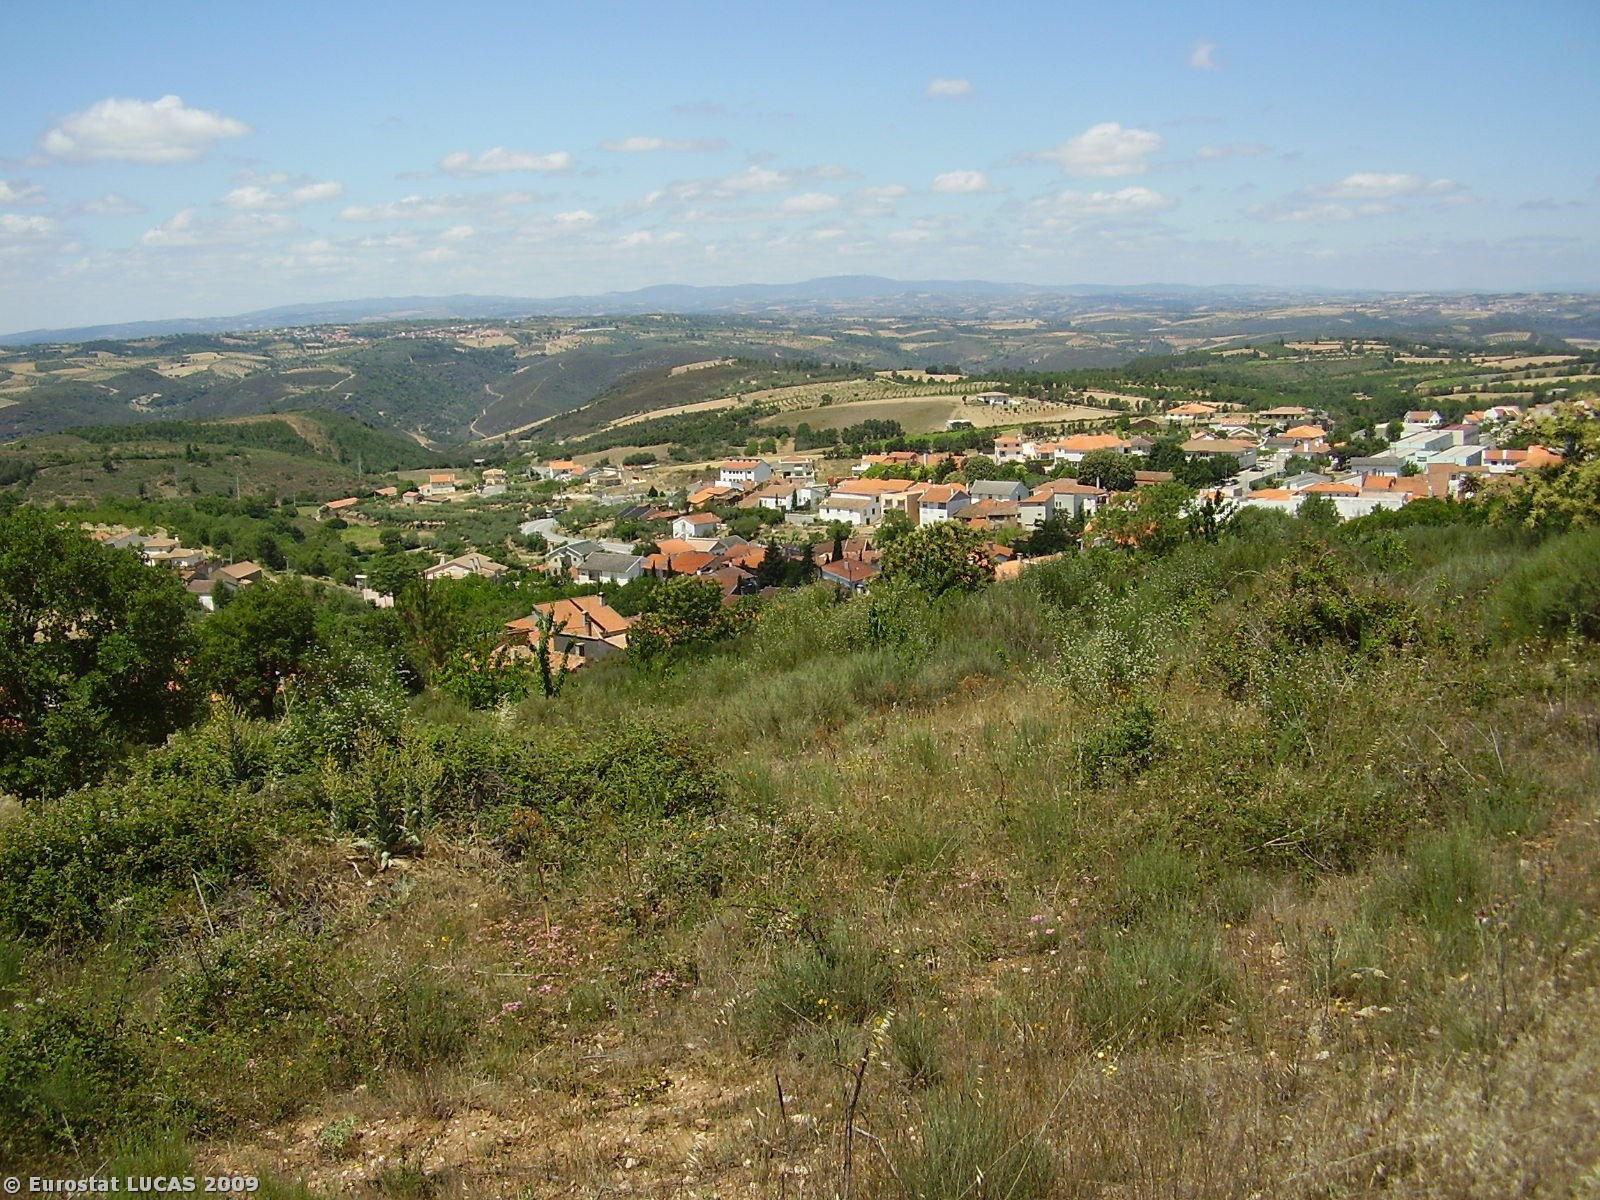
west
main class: Shrubland
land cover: Shrubland with sparse tree cover
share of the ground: 10 - 25 %
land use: Unused
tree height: > 5 m
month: June
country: PT
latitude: 41.5801
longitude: -6.5246
